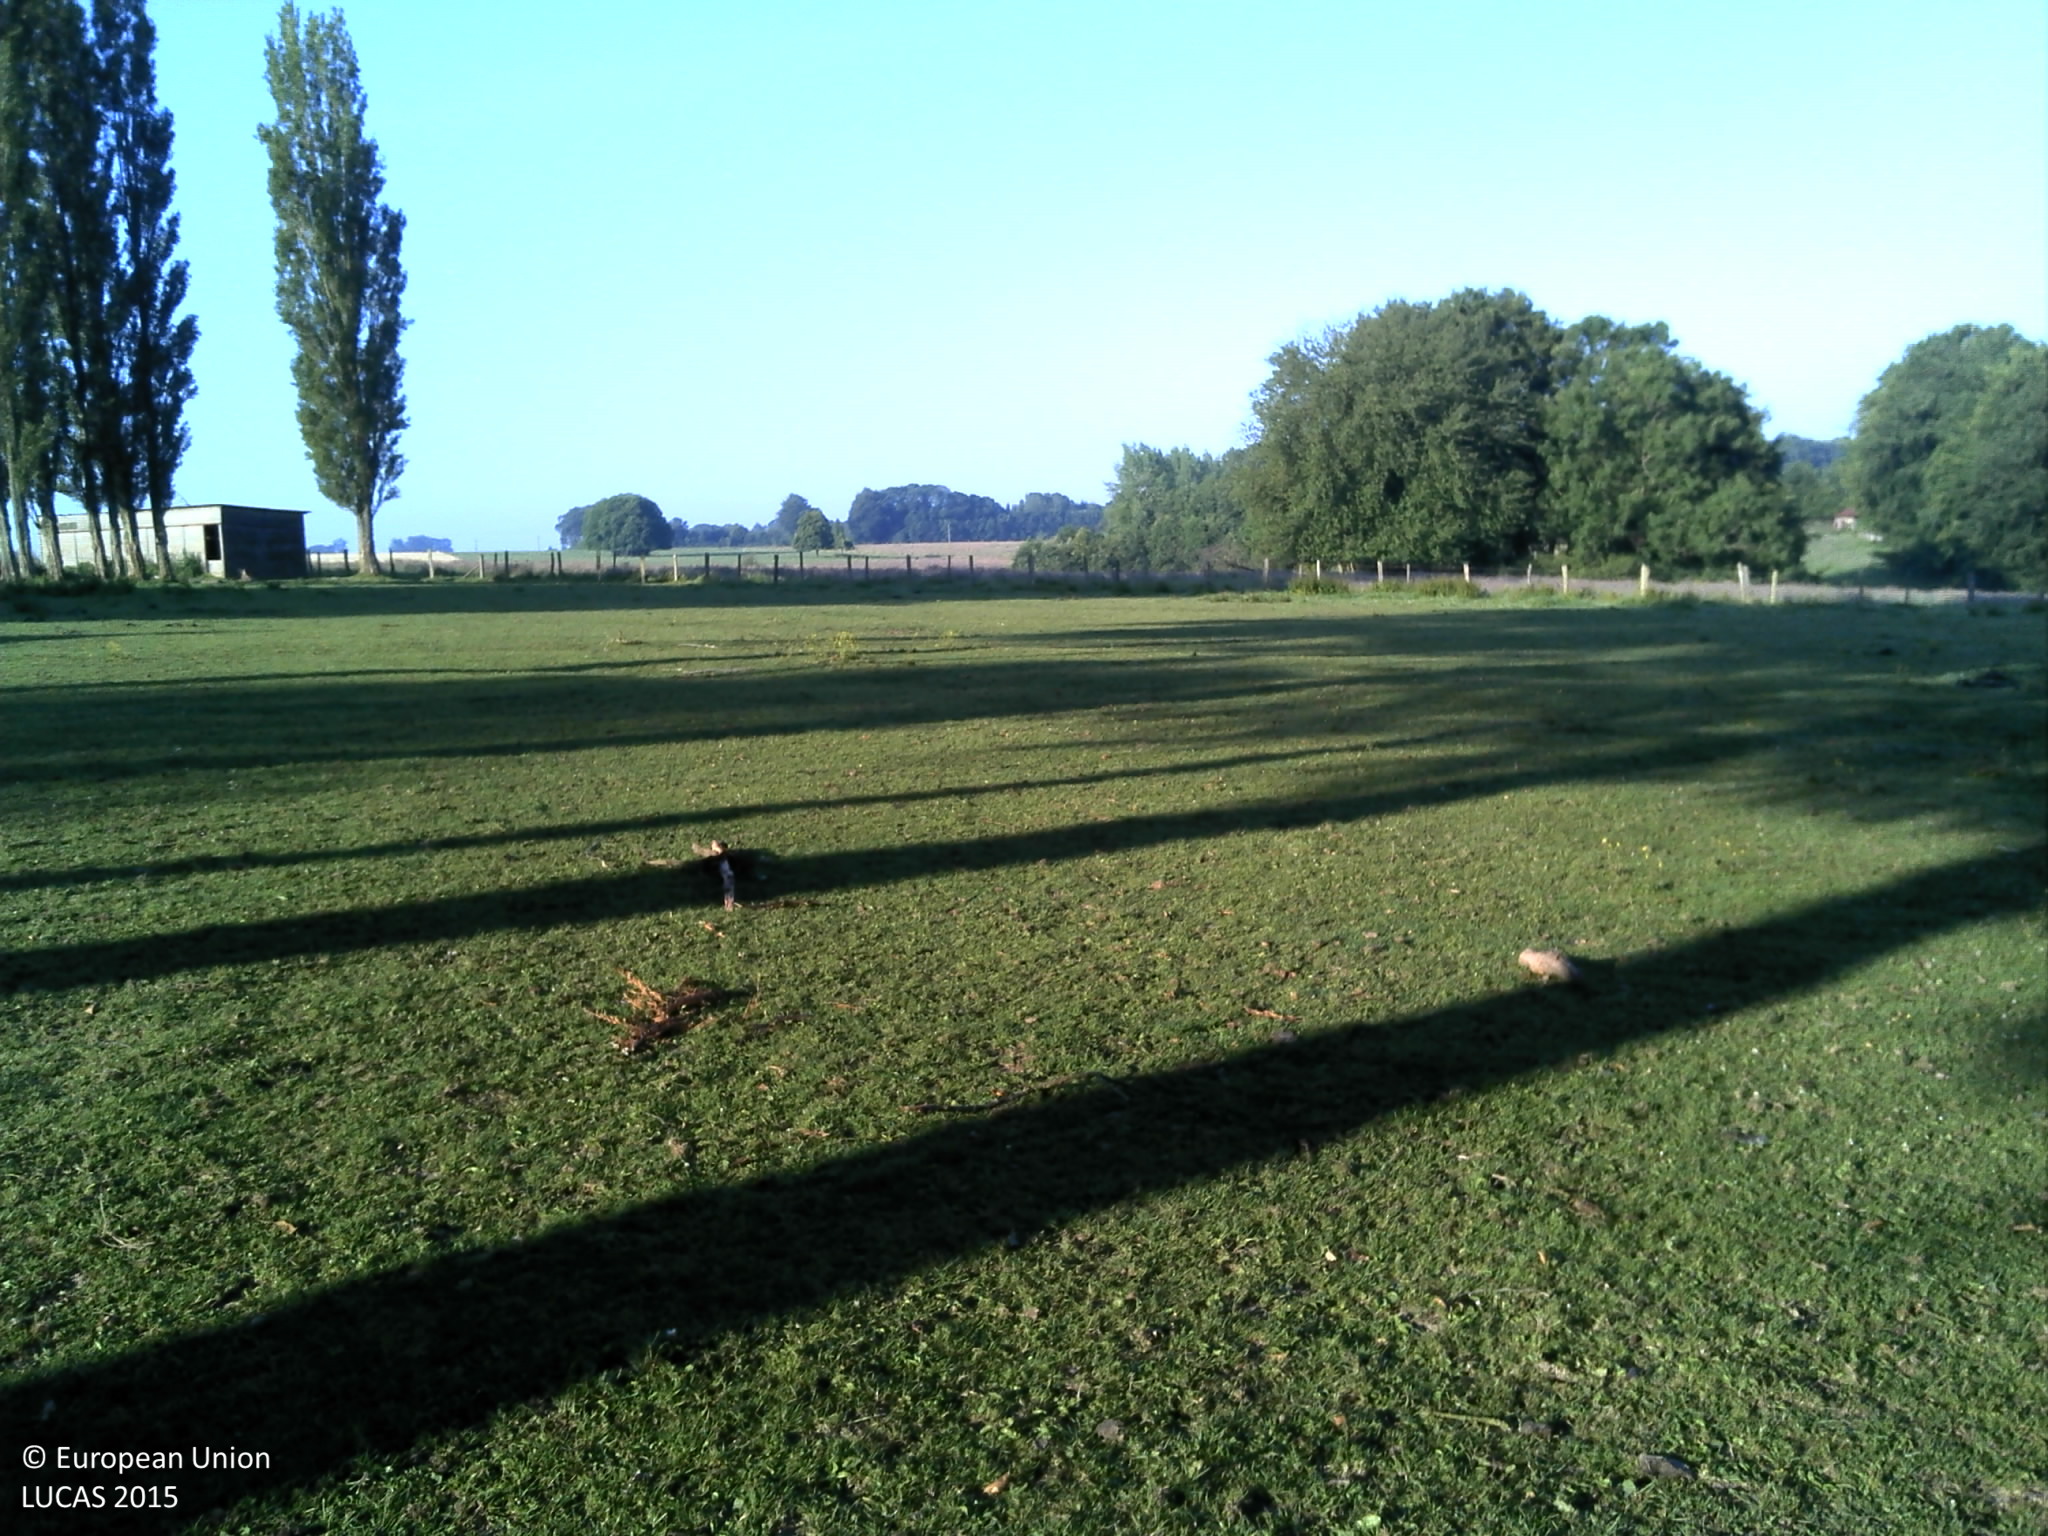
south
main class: Grassland
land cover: Grassland without tree/shrub cover
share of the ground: > 75 %
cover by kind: herbaceous plants 100 %
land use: Agriculture (excluding fallow land and kitchen gardens)
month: June
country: FR
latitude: 49.5602
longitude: 0.3915
